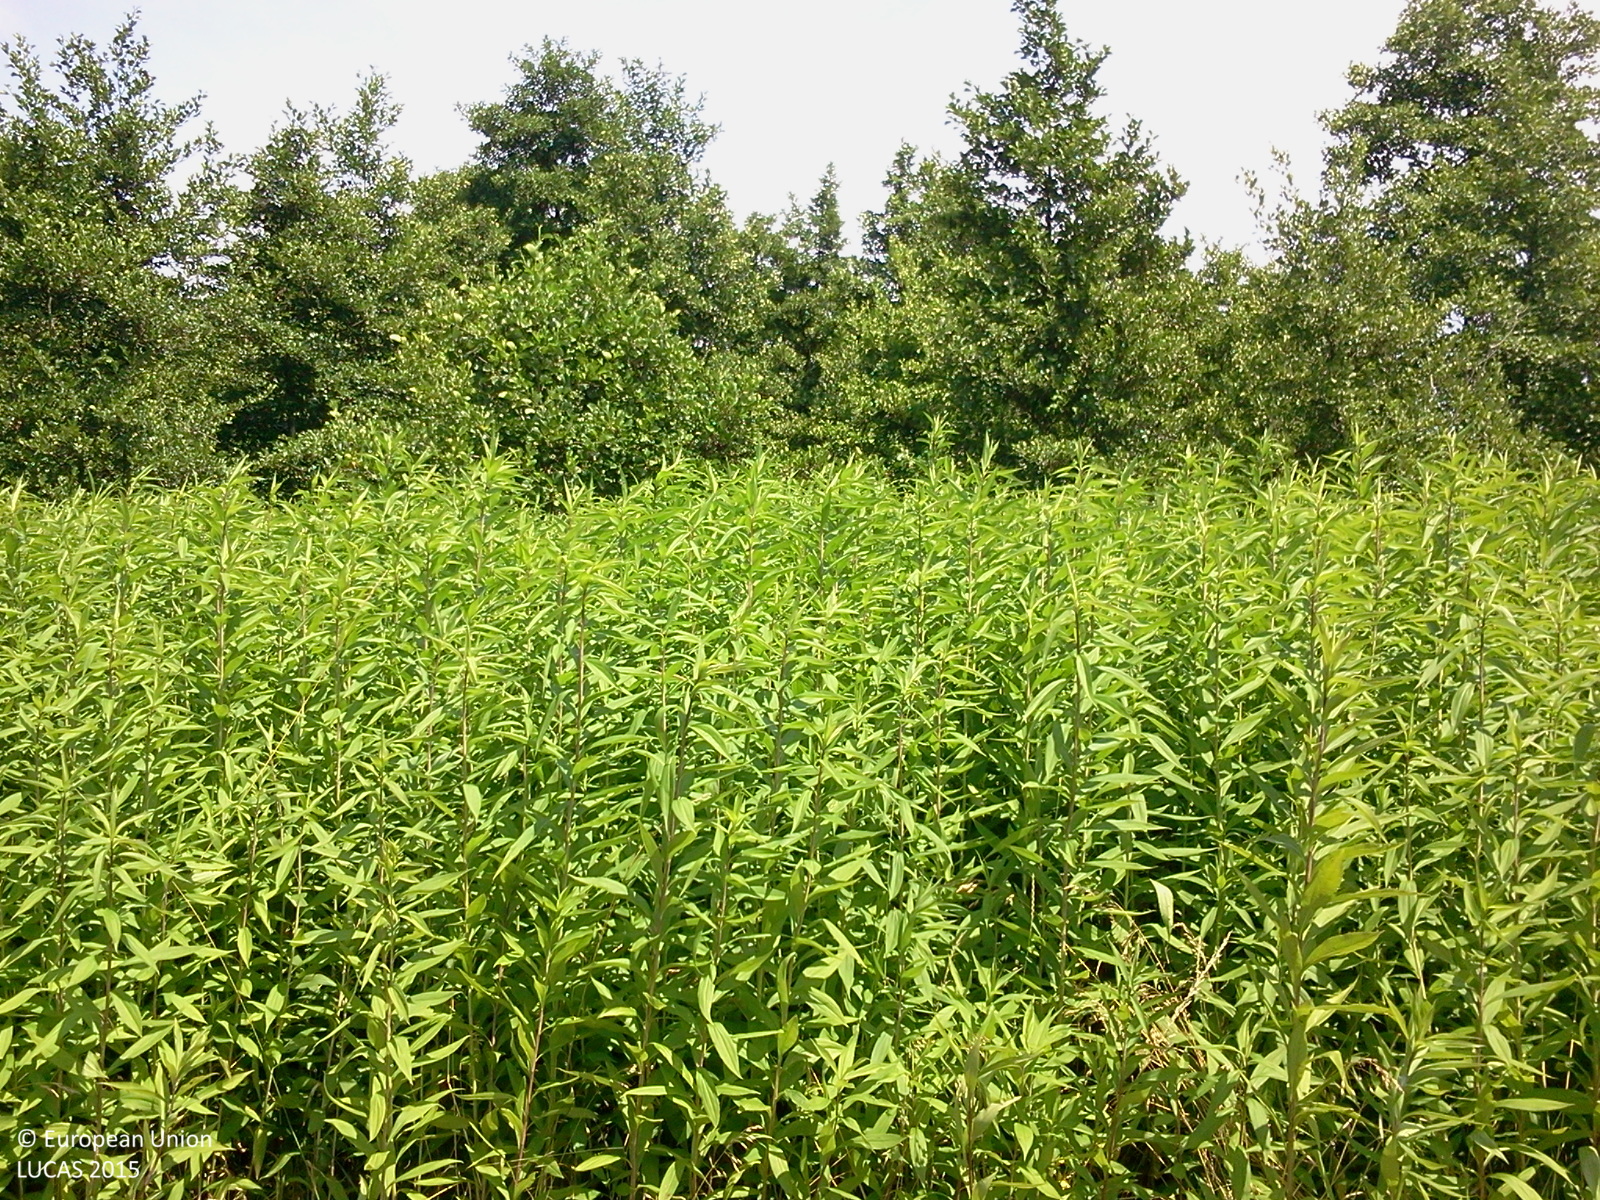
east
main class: Grassland
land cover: Grassland without tree/shrub cover
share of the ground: > 75 %
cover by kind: herbaceous plants 100 %
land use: Agriculture (excluding fallow land and kitchen gardens)
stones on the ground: < 10 %
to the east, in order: Grassland without tree/shrub cover; Grassland with sparse tree/shrub cover; Broadleaved woodland; Grassland with sparse tree/shrub cover; Grassland without tree/shrub cover; Grassland with sparse tree/shrub cover; Grassland without tree/shrub cover; Grassland with sparse tree/shrub cover
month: June
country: HU
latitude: 46.7377
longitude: 16.9790
